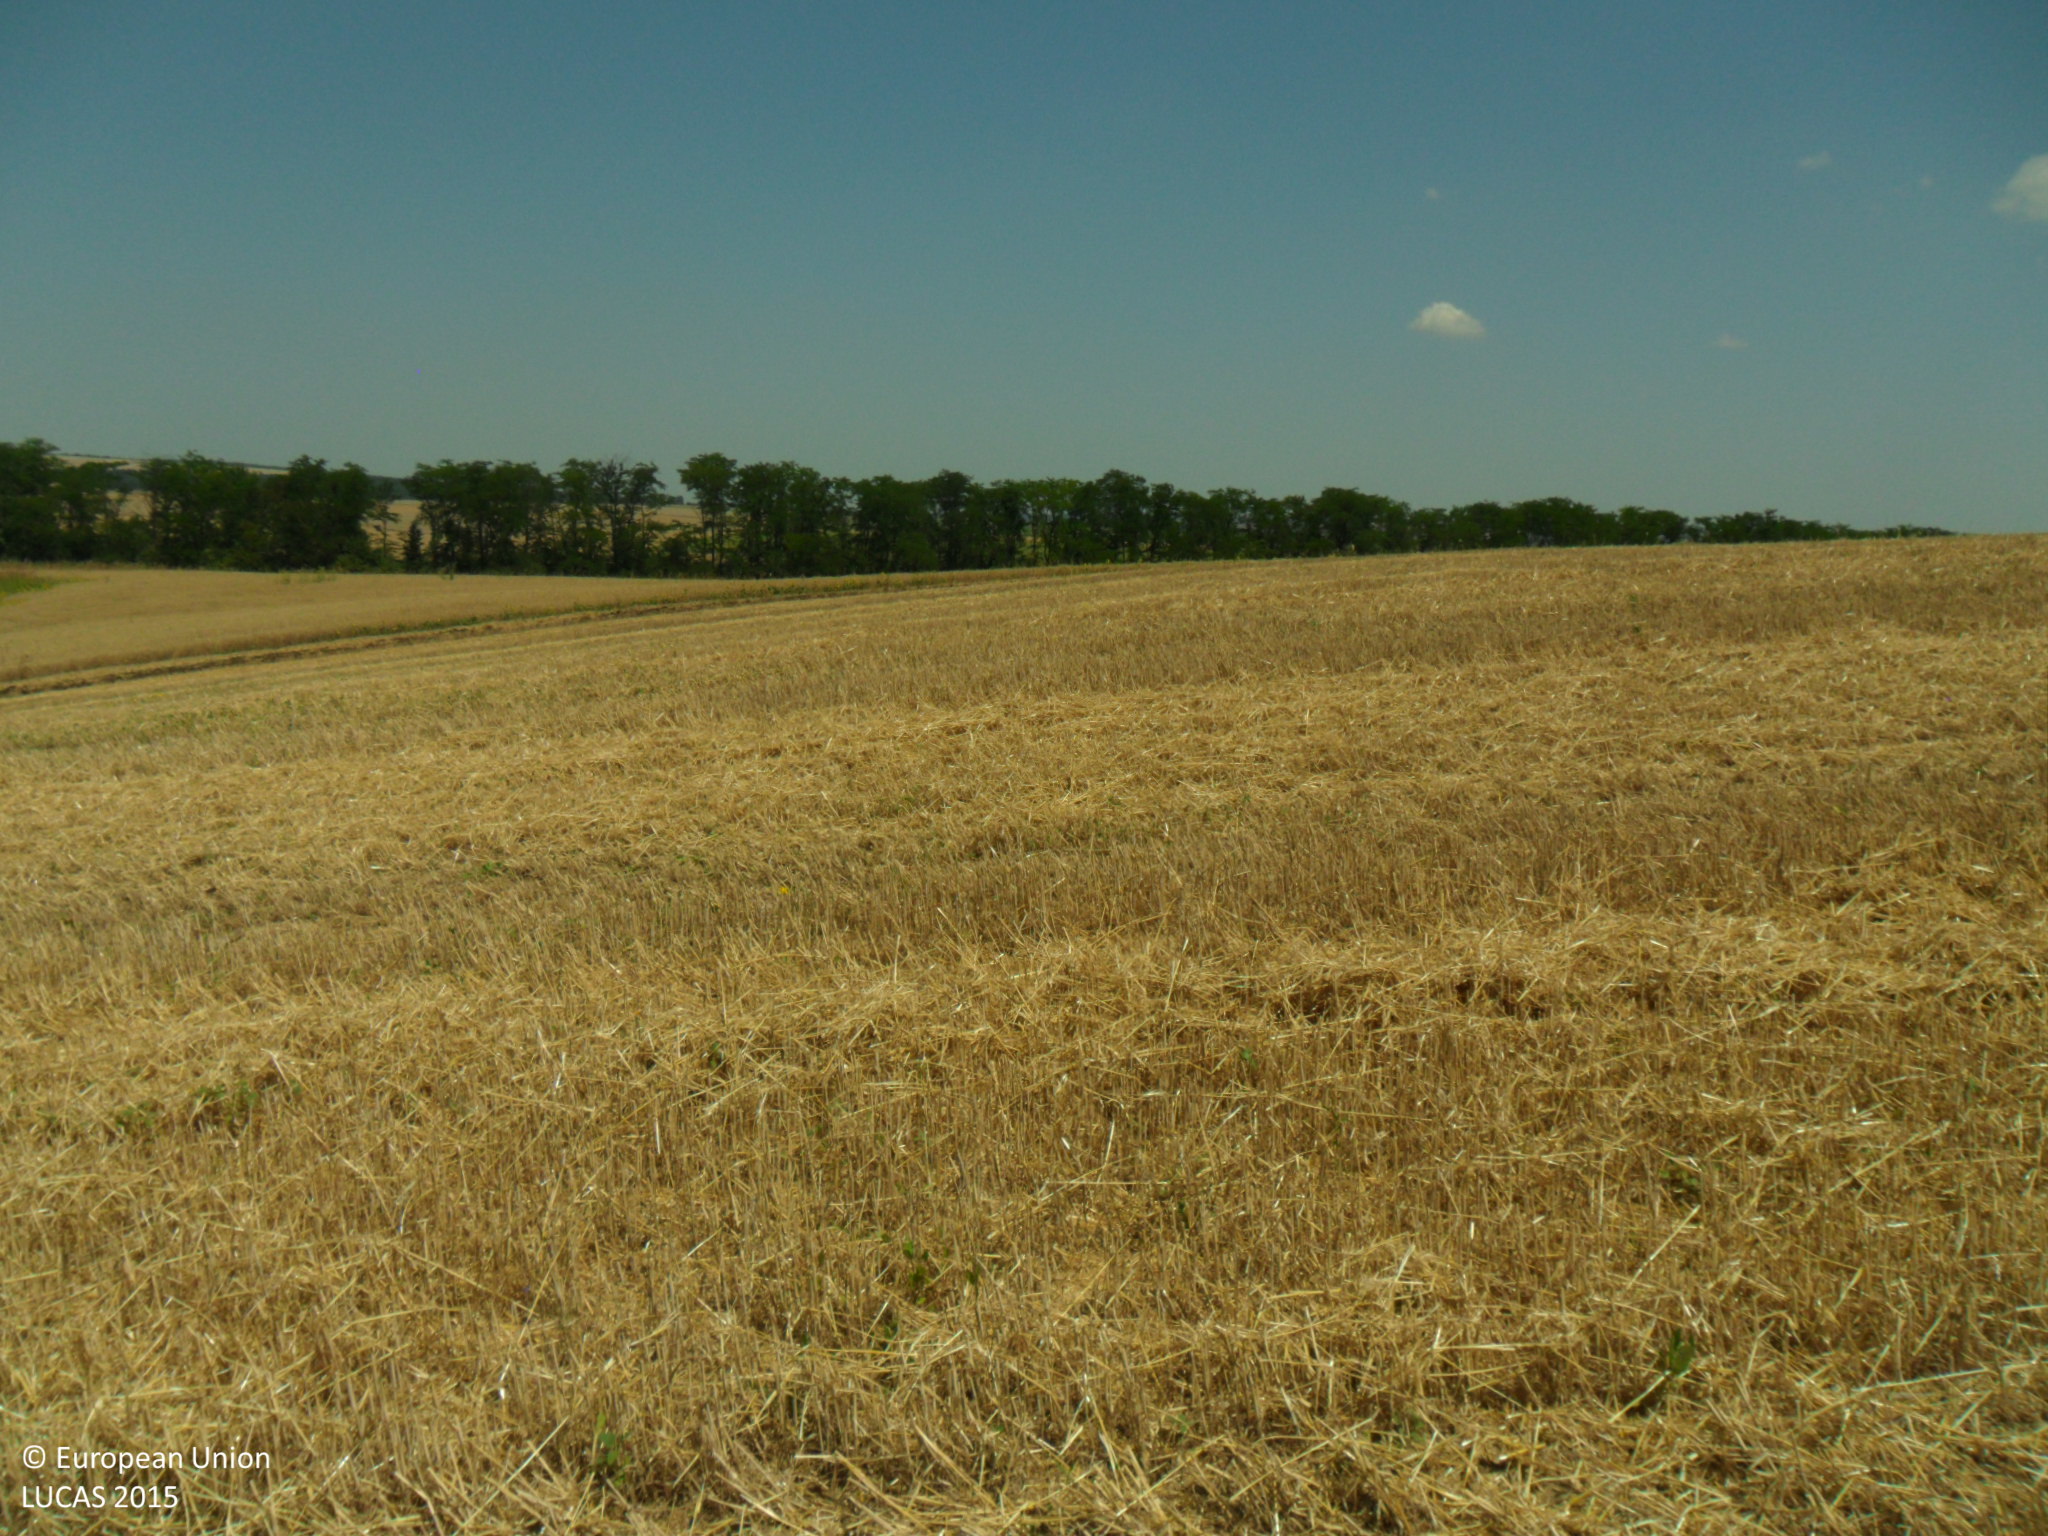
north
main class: Cropland
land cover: Common wheat
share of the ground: 50 - 75 %
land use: Agriculture (excluding fallow land and kitchen gardens)
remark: Harvested field
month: July
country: BG
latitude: 43.4001
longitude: 26.6397
